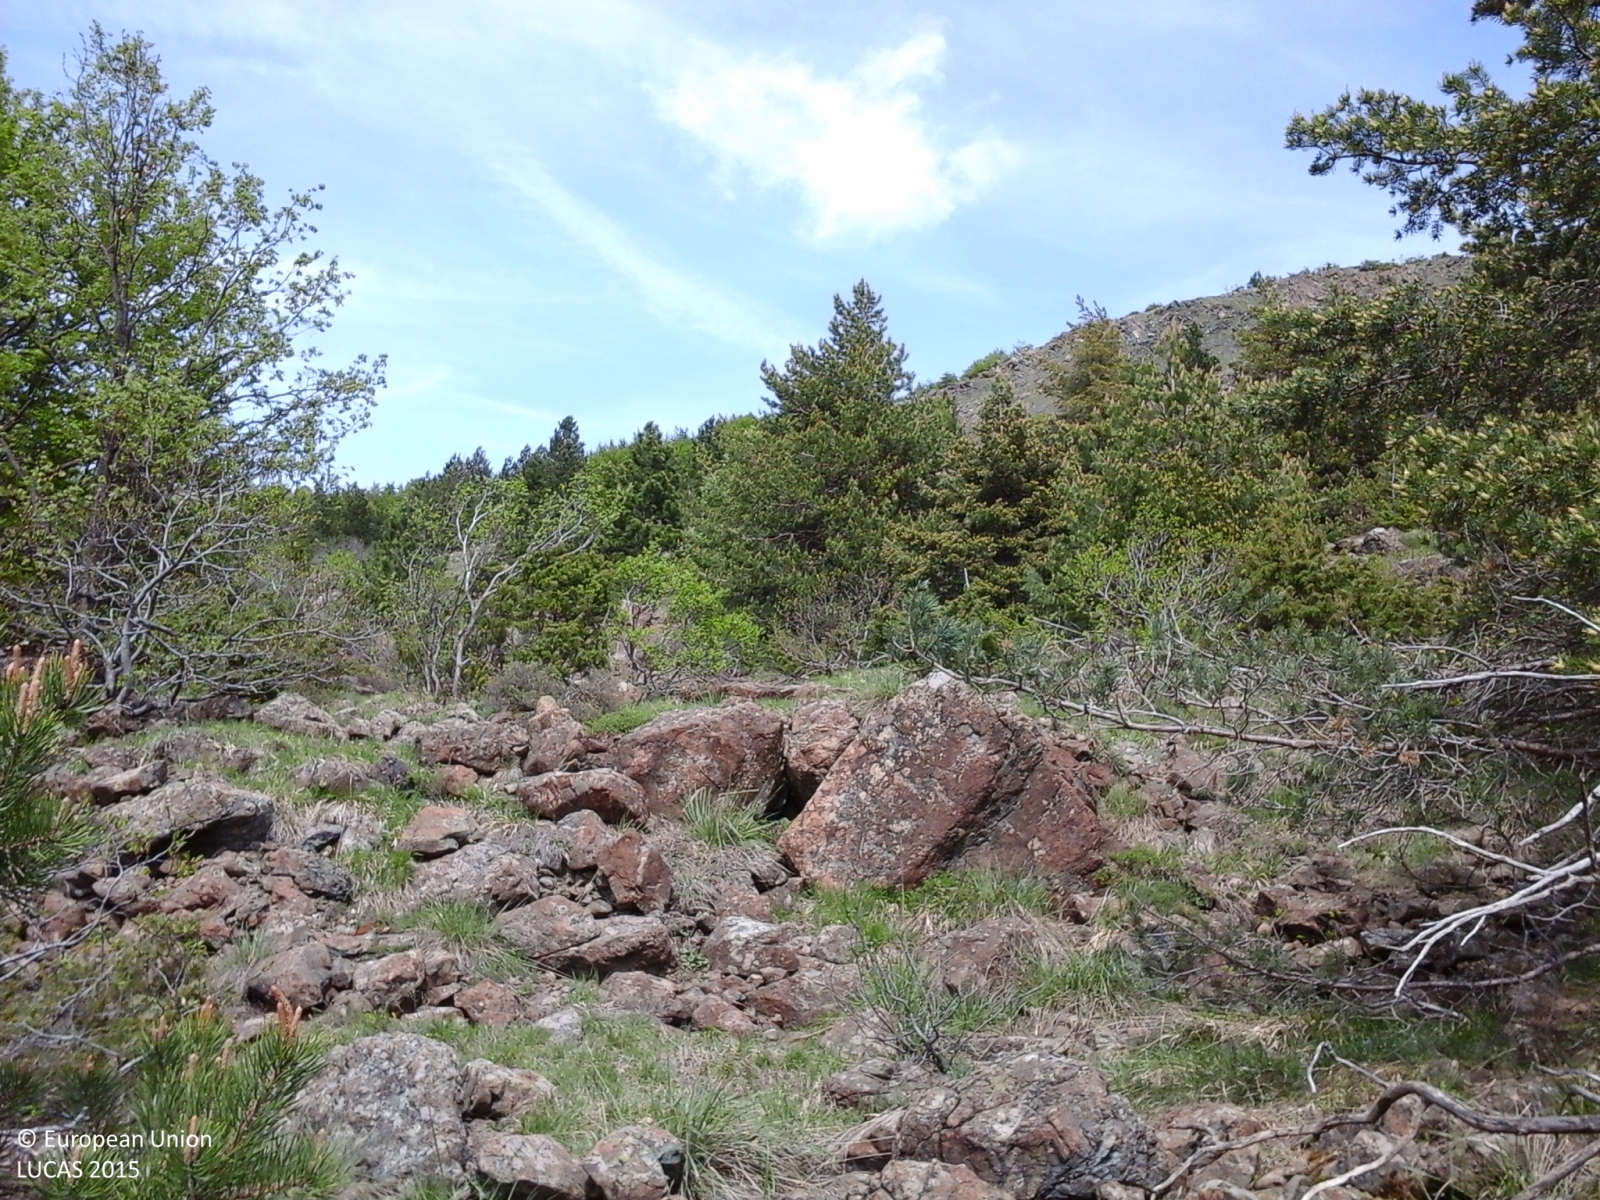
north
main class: Woodland
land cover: Other mixed woodland
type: alpine coniferous forest
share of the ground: > 75 %
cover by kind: coniferous forest trees 60 %, broadleaved forest trees 30 %, shrubs 10 %
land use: Semi-natural and natural areas not in use
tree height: > 5 m
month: May
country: IT
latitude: 44.6019
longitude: 9.5097
